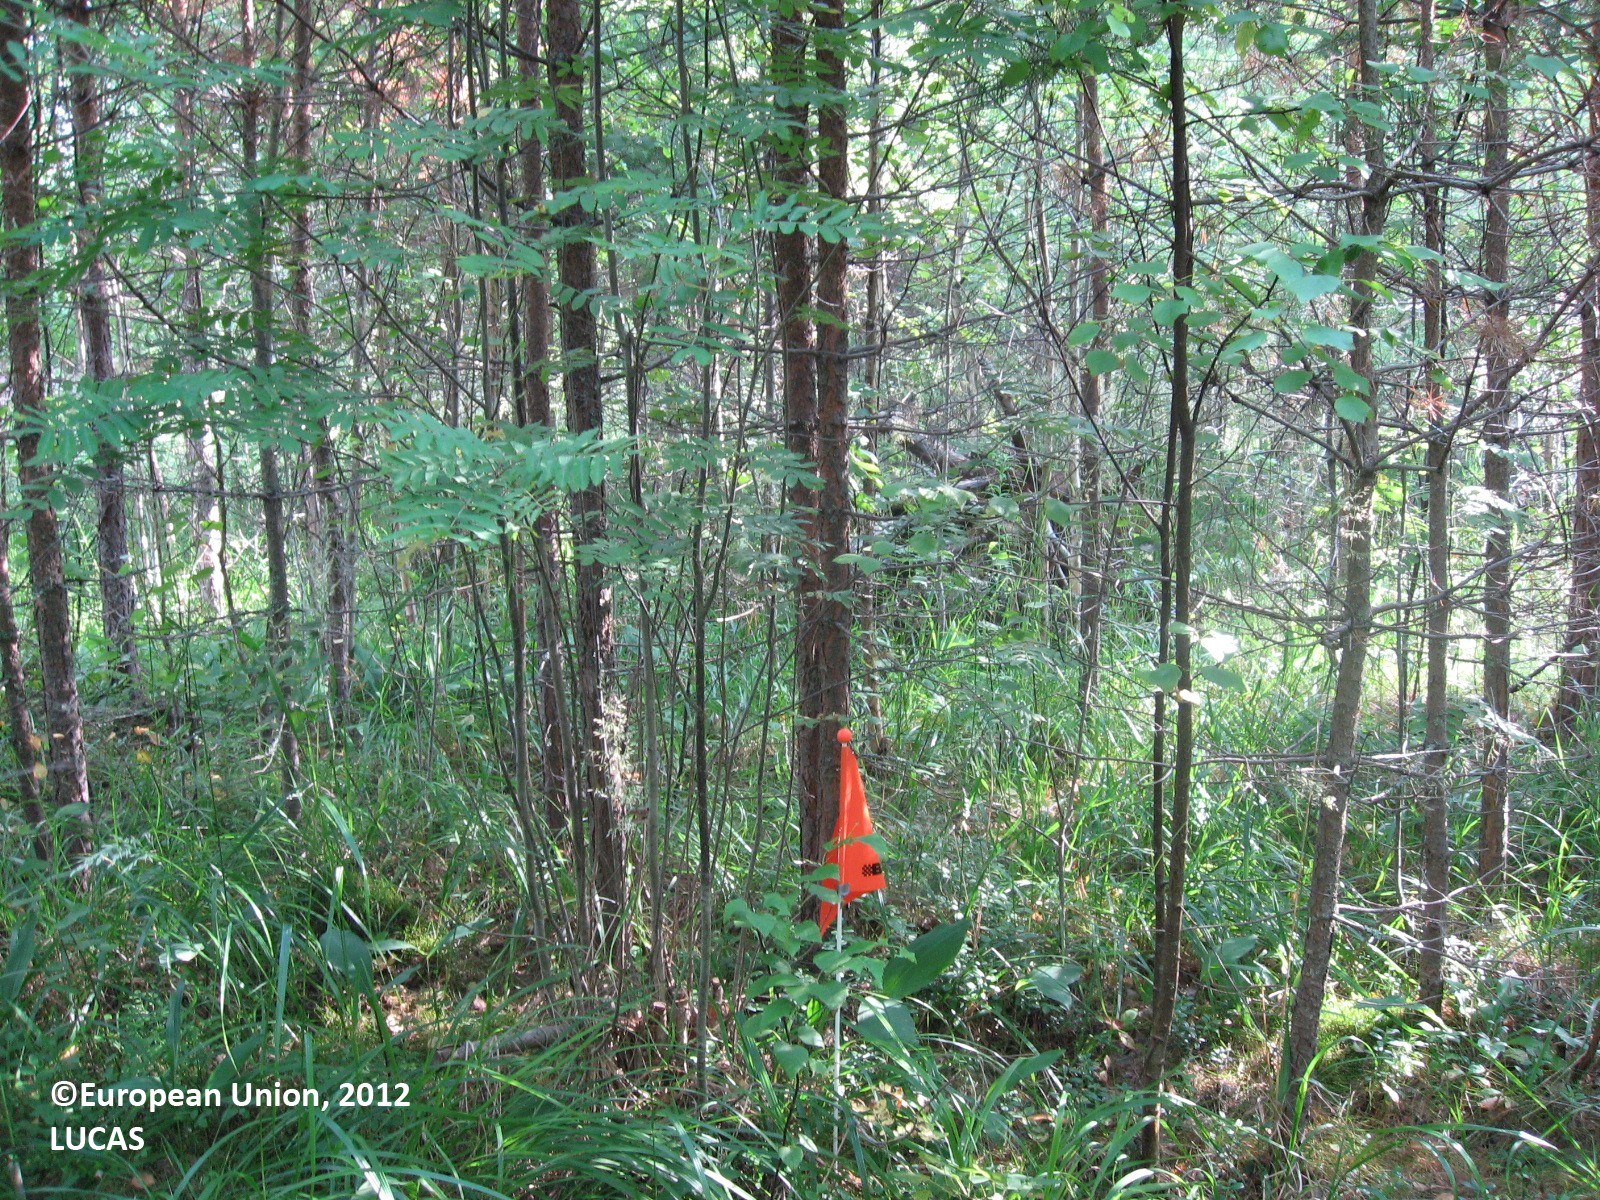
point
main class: Woodland
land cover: Pine dominated mixed woodland
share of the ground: > 75 %
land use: Forestry
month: August
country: FI
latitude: 61.4758
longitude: 25.9578
